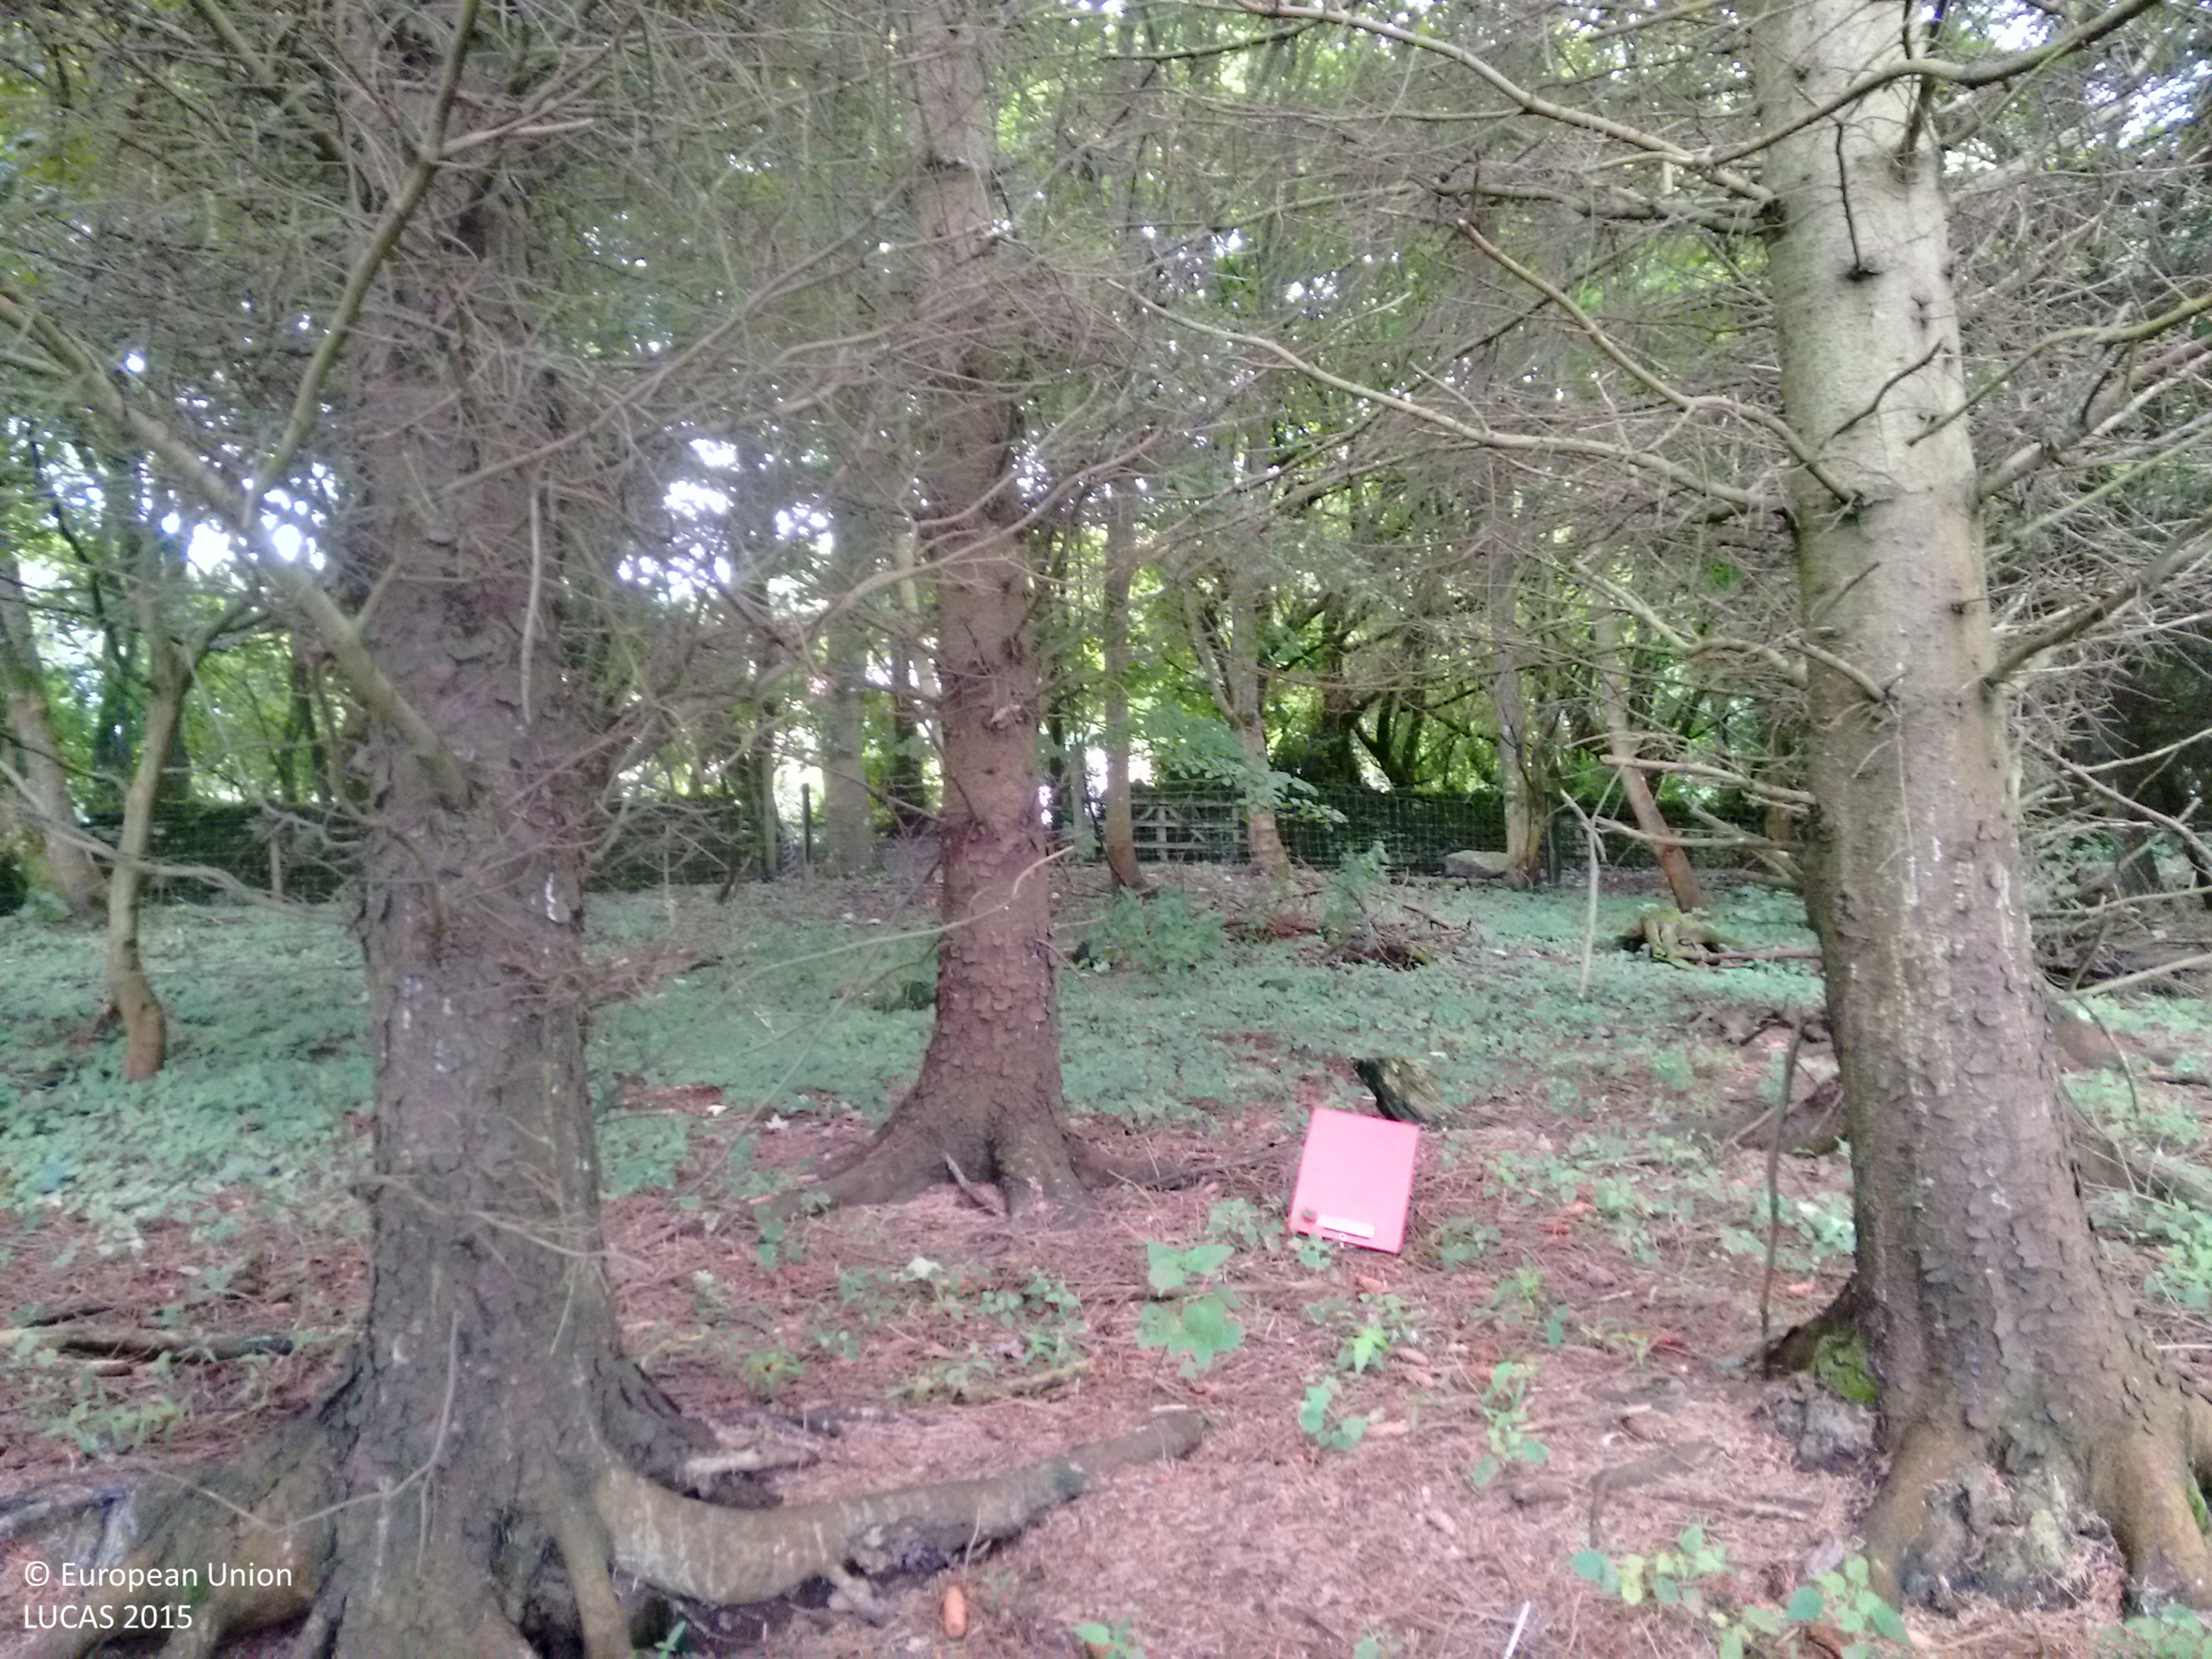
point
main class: Woodland
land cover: Other mixed woodland
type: exotic forest
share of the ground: > 75 %
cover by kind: coniferous forest trees 75 %, broadleaved forest trees 25 %
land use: Agriculture (excluding fallow land and kitchen gardens)
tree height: > 5 m
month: August
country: GB
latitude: 58.3921
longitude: -3.1455
